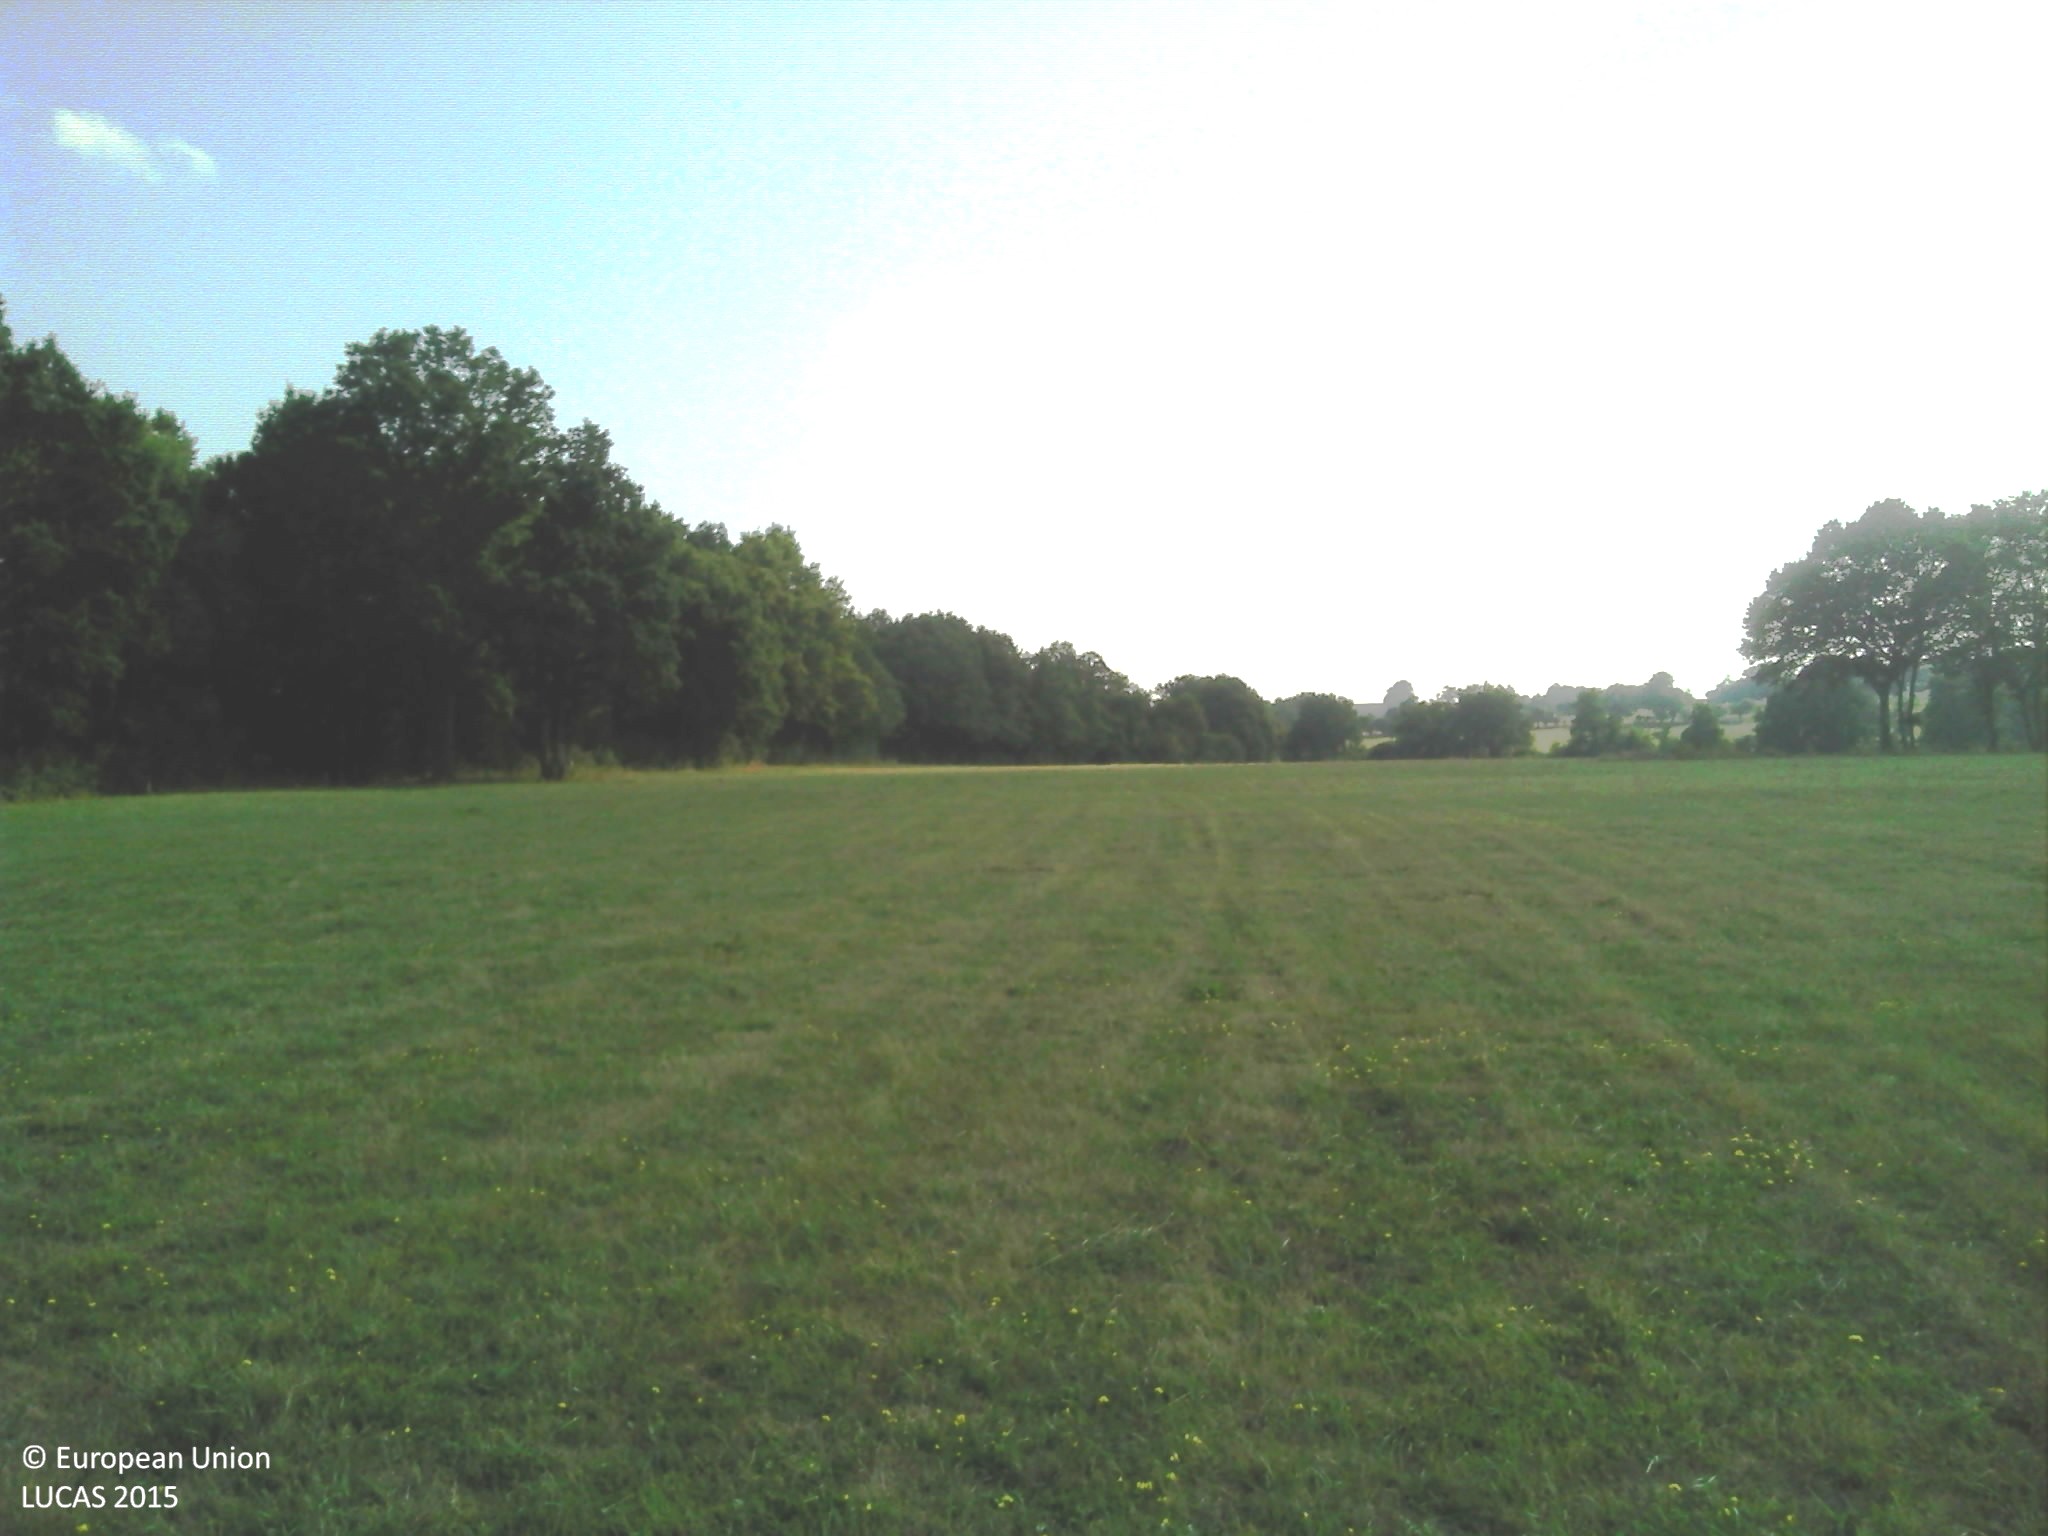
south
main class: Grassland
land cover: Grassland without tree/shrub cover
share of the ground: > 75 %
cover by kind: herbaceous plants 100 %
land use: Agriculture (excluding fallow land and kitchen gardens)
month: August
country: FR
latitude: 47.0159
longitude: 4.3827
